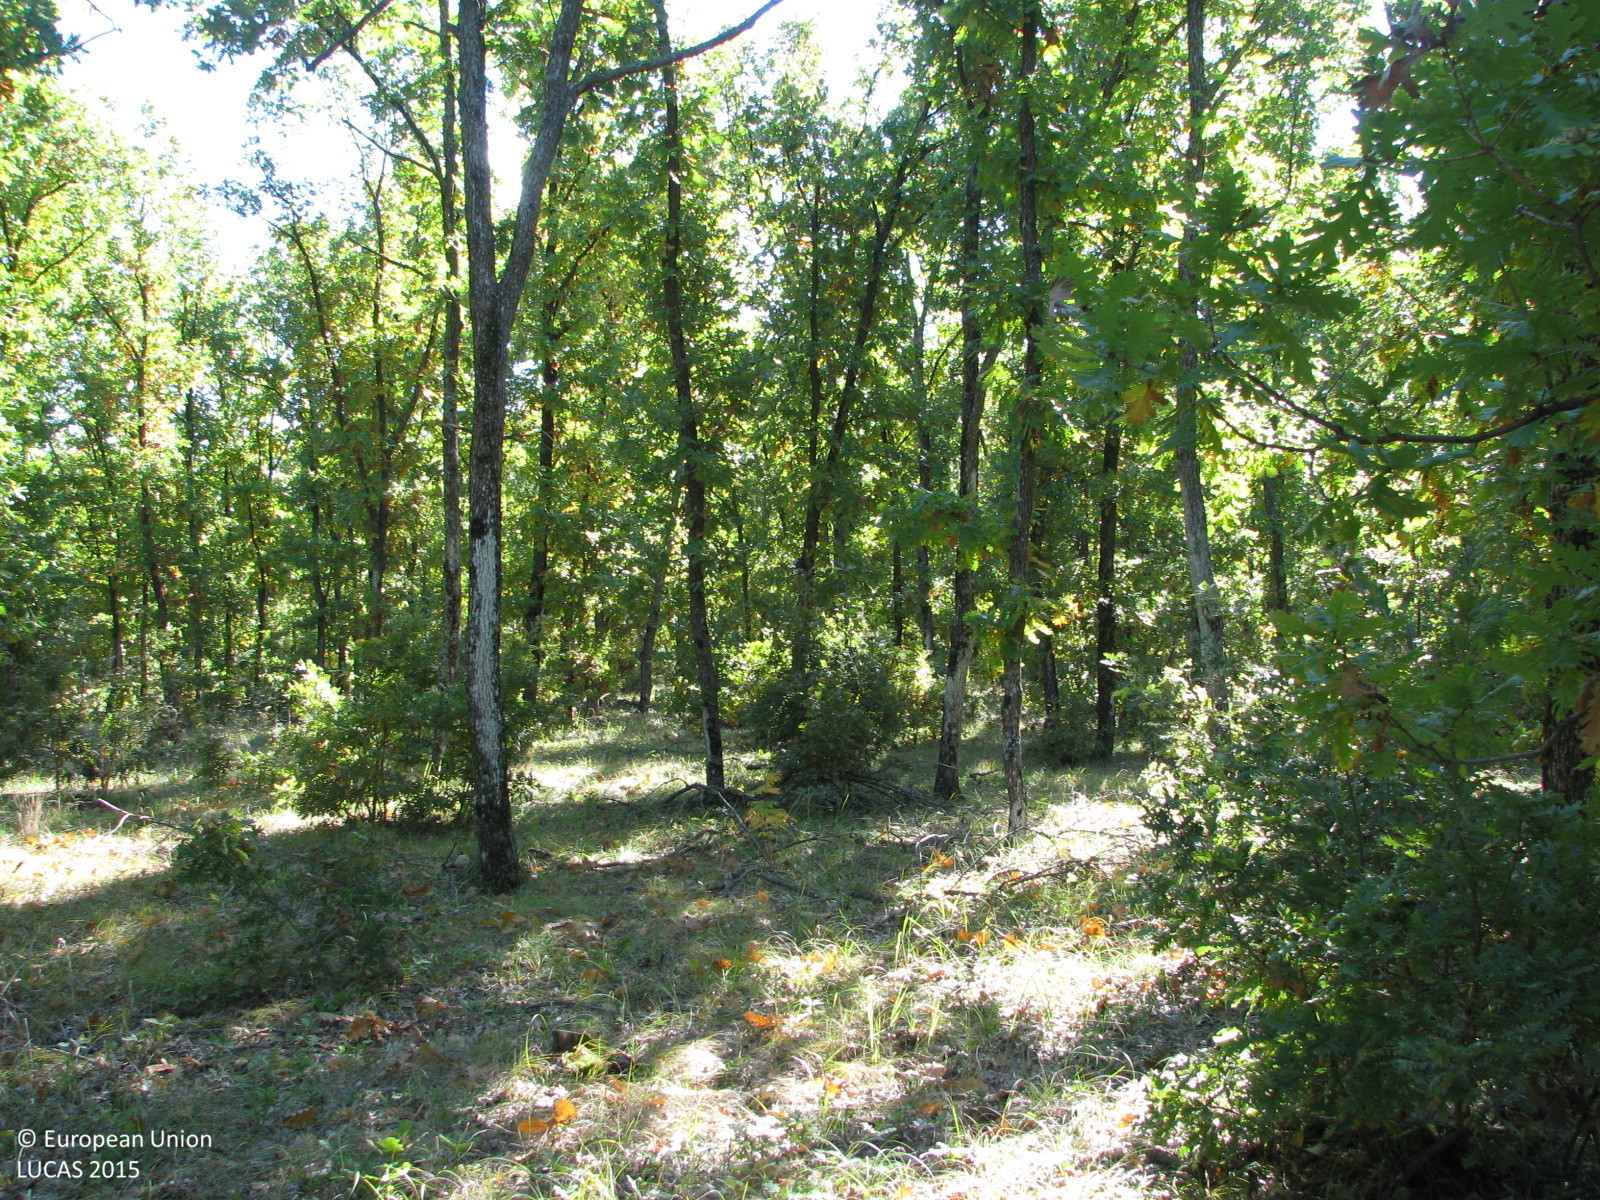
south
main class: Woodland
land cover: Broadleaved woodland
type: mesophytic deciduous forest
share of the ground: 50 - 75 %
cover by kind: broadleaved forest trees 70 %, herbaceous plants 25 %, shrubs 5 %
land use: Forestry
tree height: > 5 m
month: October
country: BG
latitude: 42.1566
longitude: 26.2634
